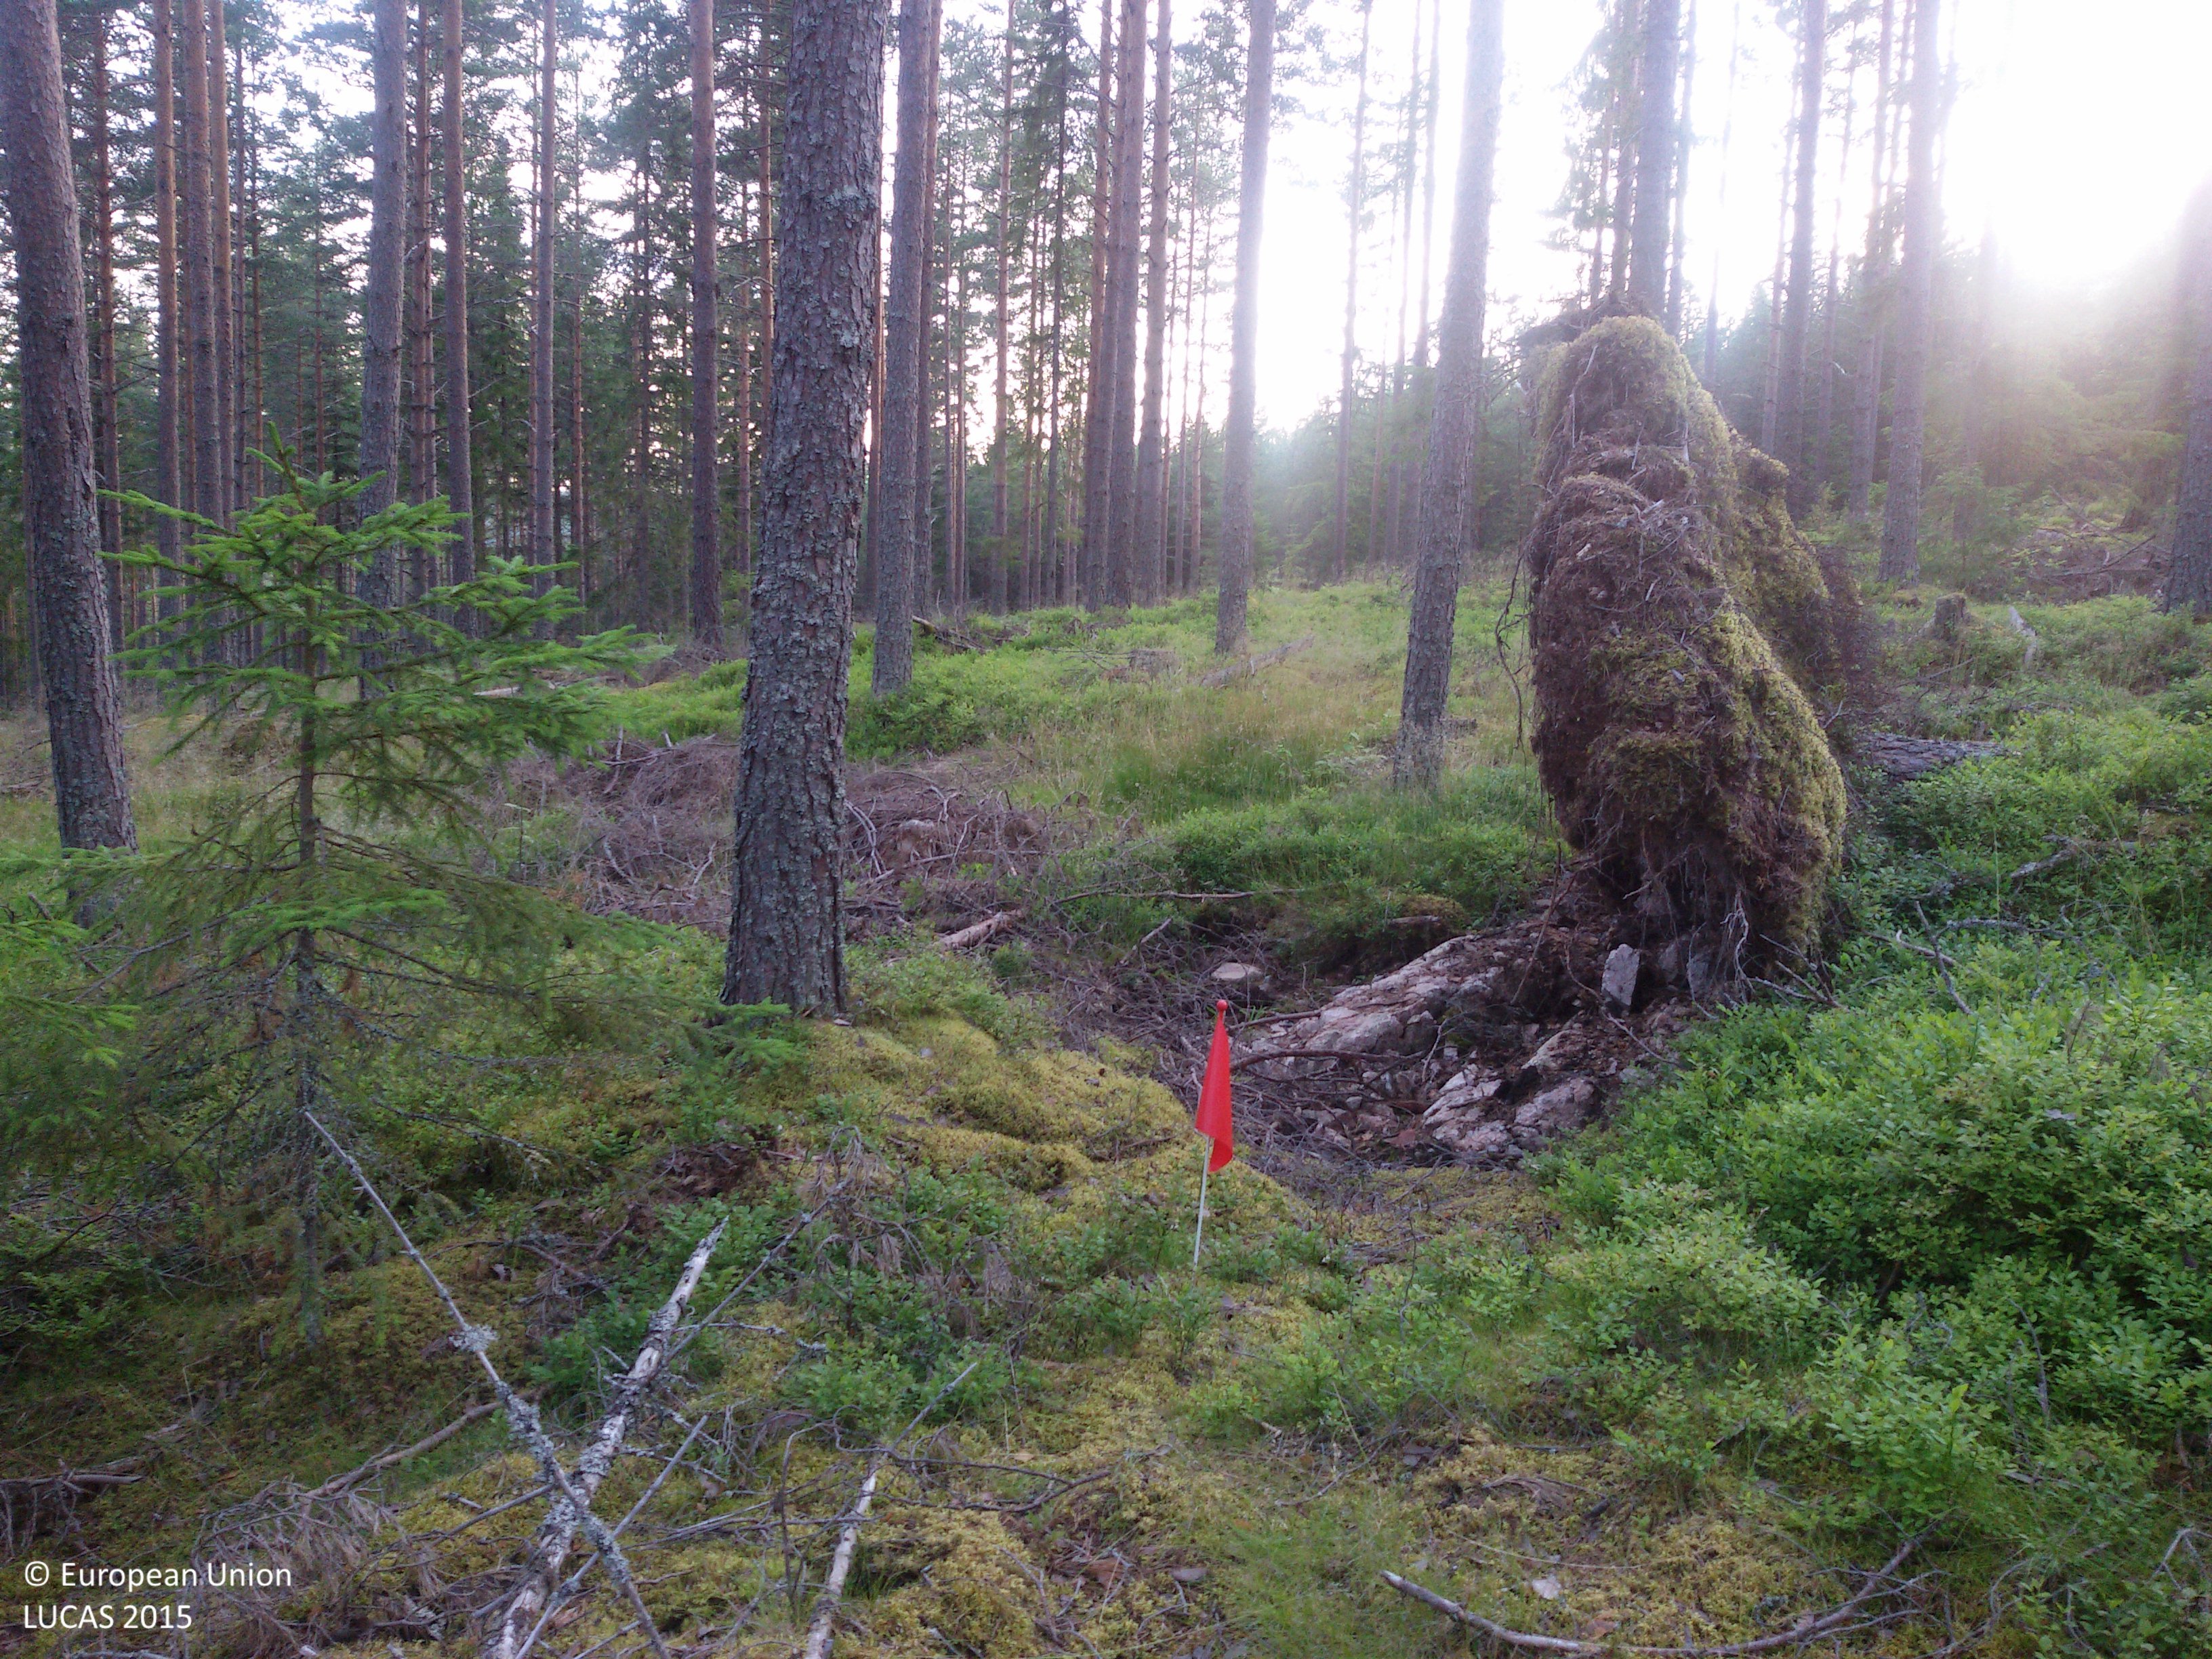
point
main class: Woodland
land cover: Pine dominated coniferous woodland
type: boreal forest
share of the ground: 50 - 75 %
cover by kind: coniferous forest trees 75 %, lichens and mosses 20 %, herbaceous plants 5 %
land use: Forestry
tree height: > 5 m
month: July
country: SE
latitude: 60.5264
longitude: 14.9619
